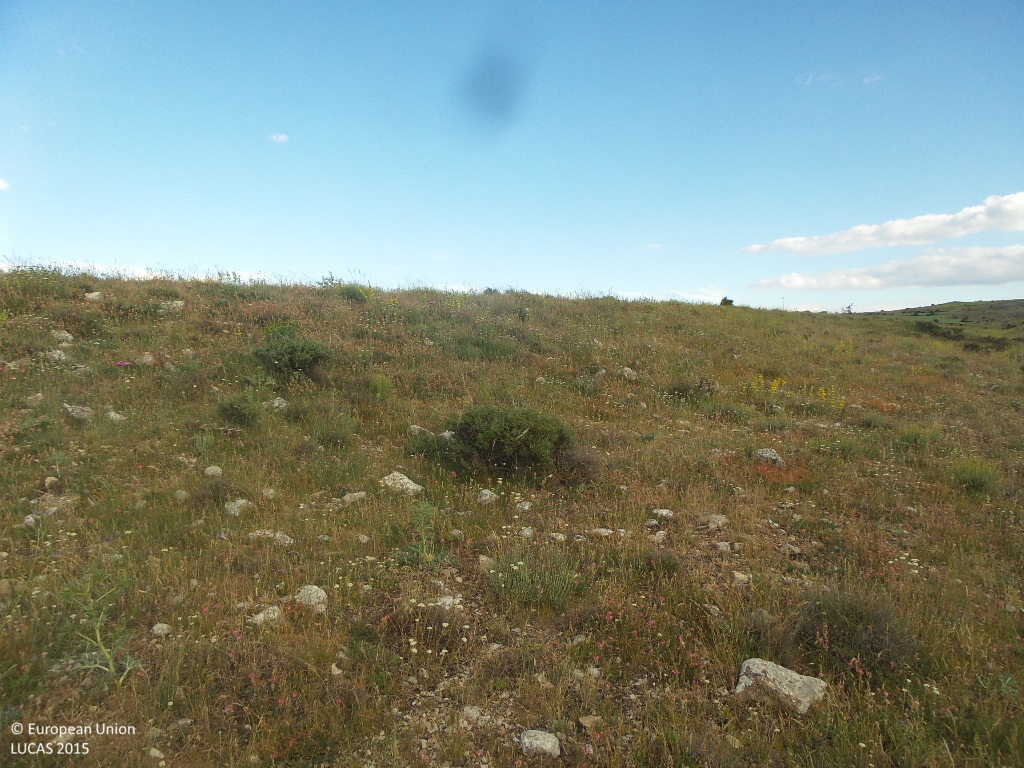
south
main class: Shrubland
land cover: Shrubland without tree cover
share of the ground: 25 - 50 %
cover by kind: shrubs 40 %, herbaceous plants 40 %, unconsolidated bare surface 20 %
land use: Semi-natural and natural areas not in use
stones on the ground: 10 - 25 %
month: June
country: ES
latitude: 41.3721
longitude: -3.0124
